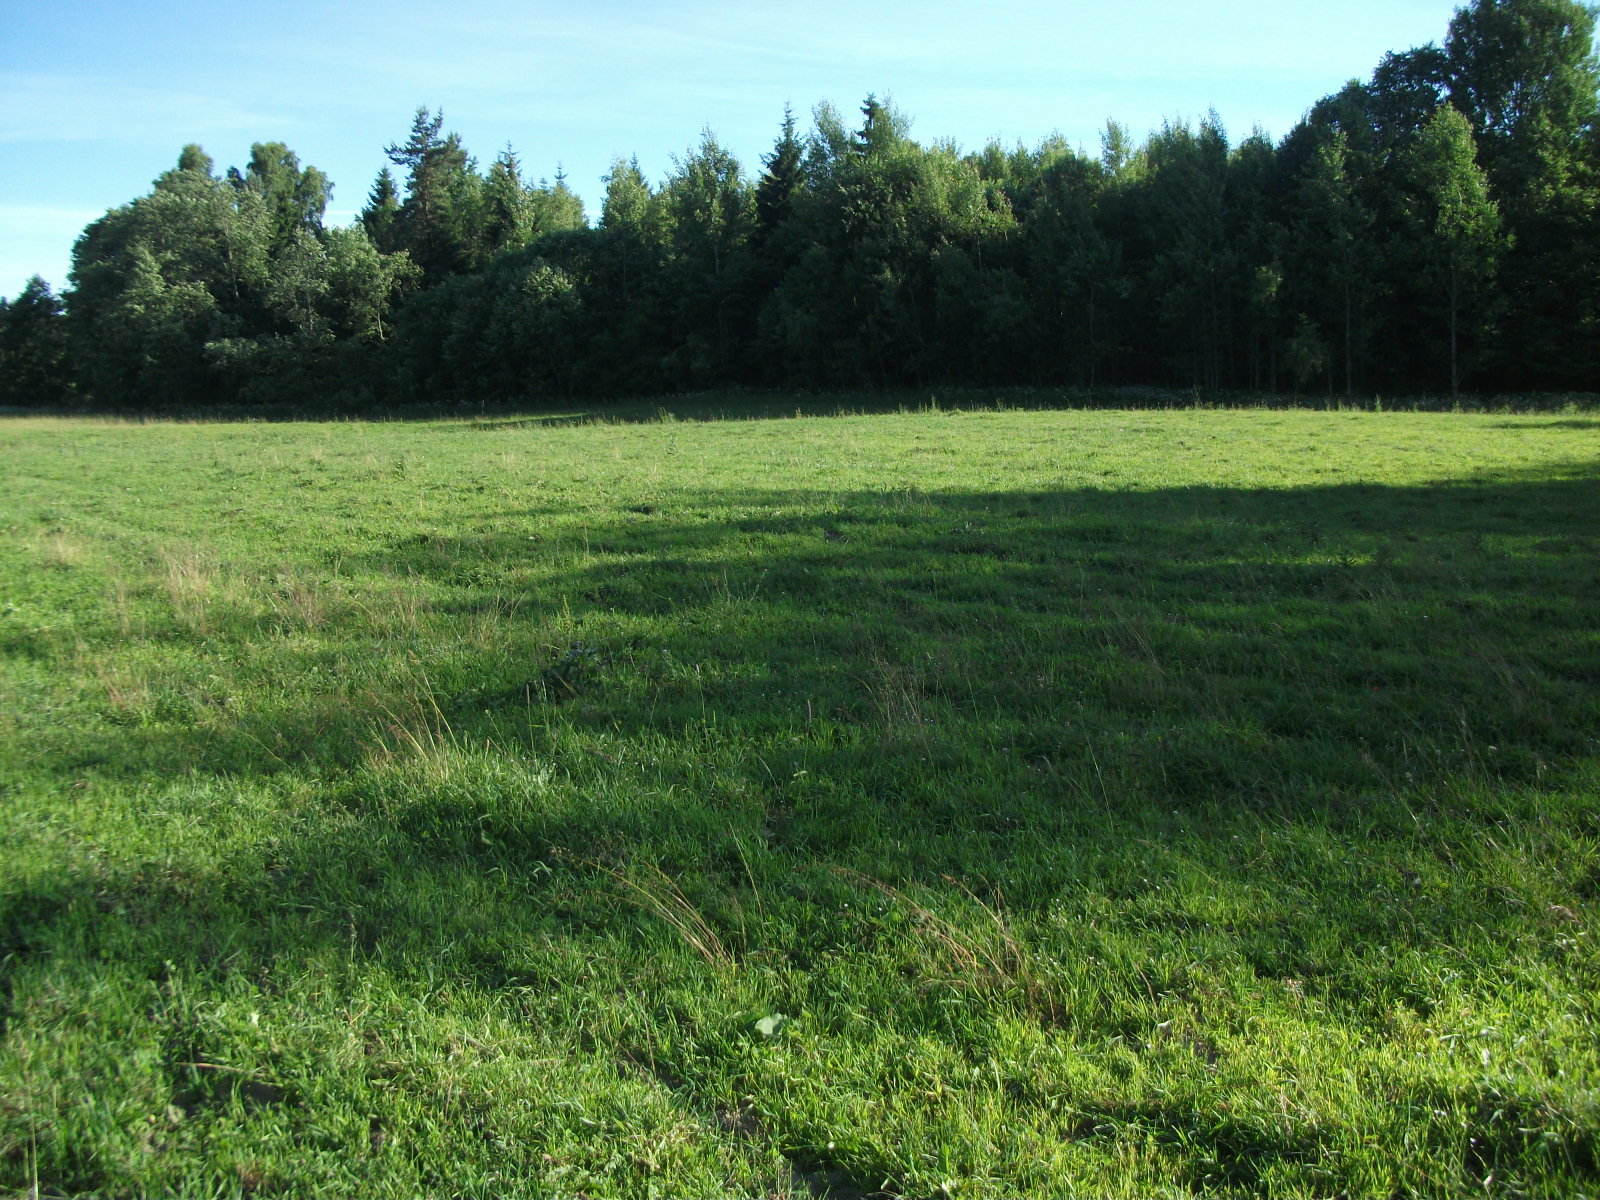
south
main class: Grassland
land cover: Grassland without tree/shrub cover
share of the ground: > 75 %
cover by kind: herbaceous plants 100 %
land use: Agriculture (excluding fallow land and kitchen gardens)
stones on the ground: < 10 %
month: July
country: LV
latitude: 56.8081
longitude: 26.3062
